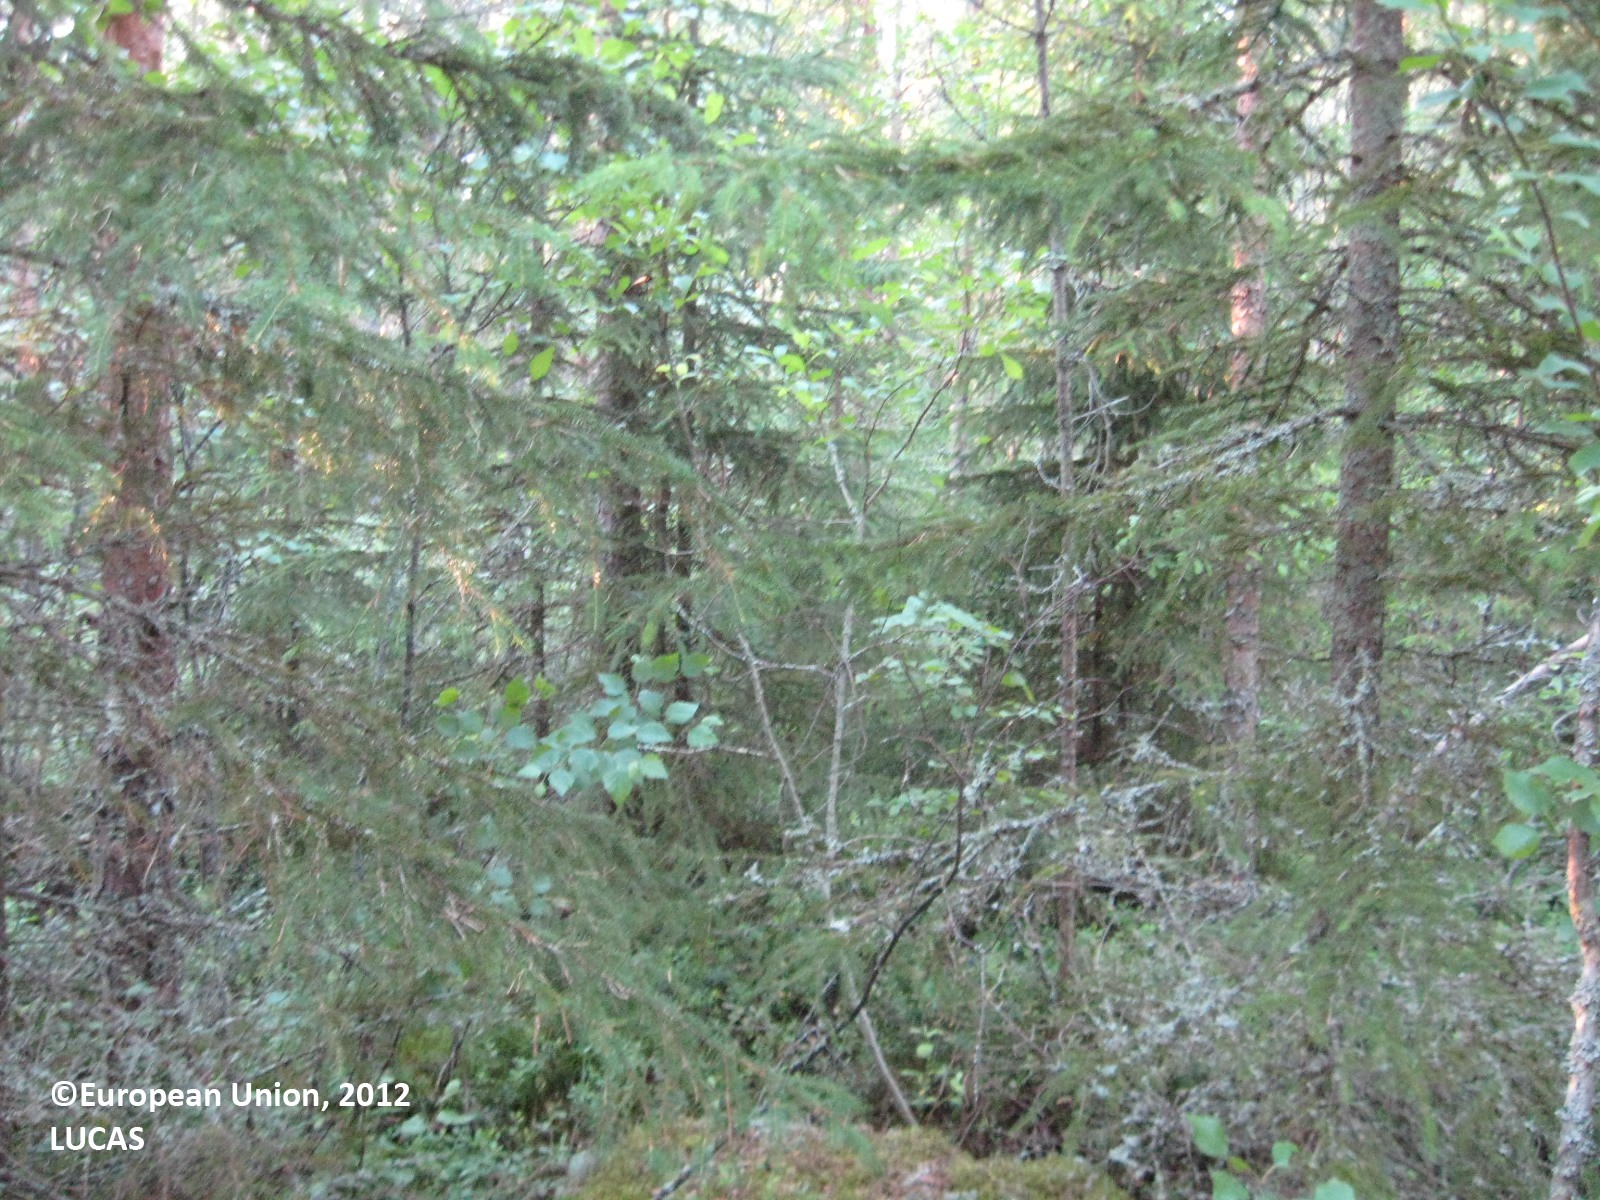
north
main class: Woodland
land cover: Pine dominated mixed woodland
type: boreal forest
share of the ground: > 75 %
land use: Forestry
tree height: > 5 m
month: July
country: FI
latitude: 62.4179
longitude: 21.6027
